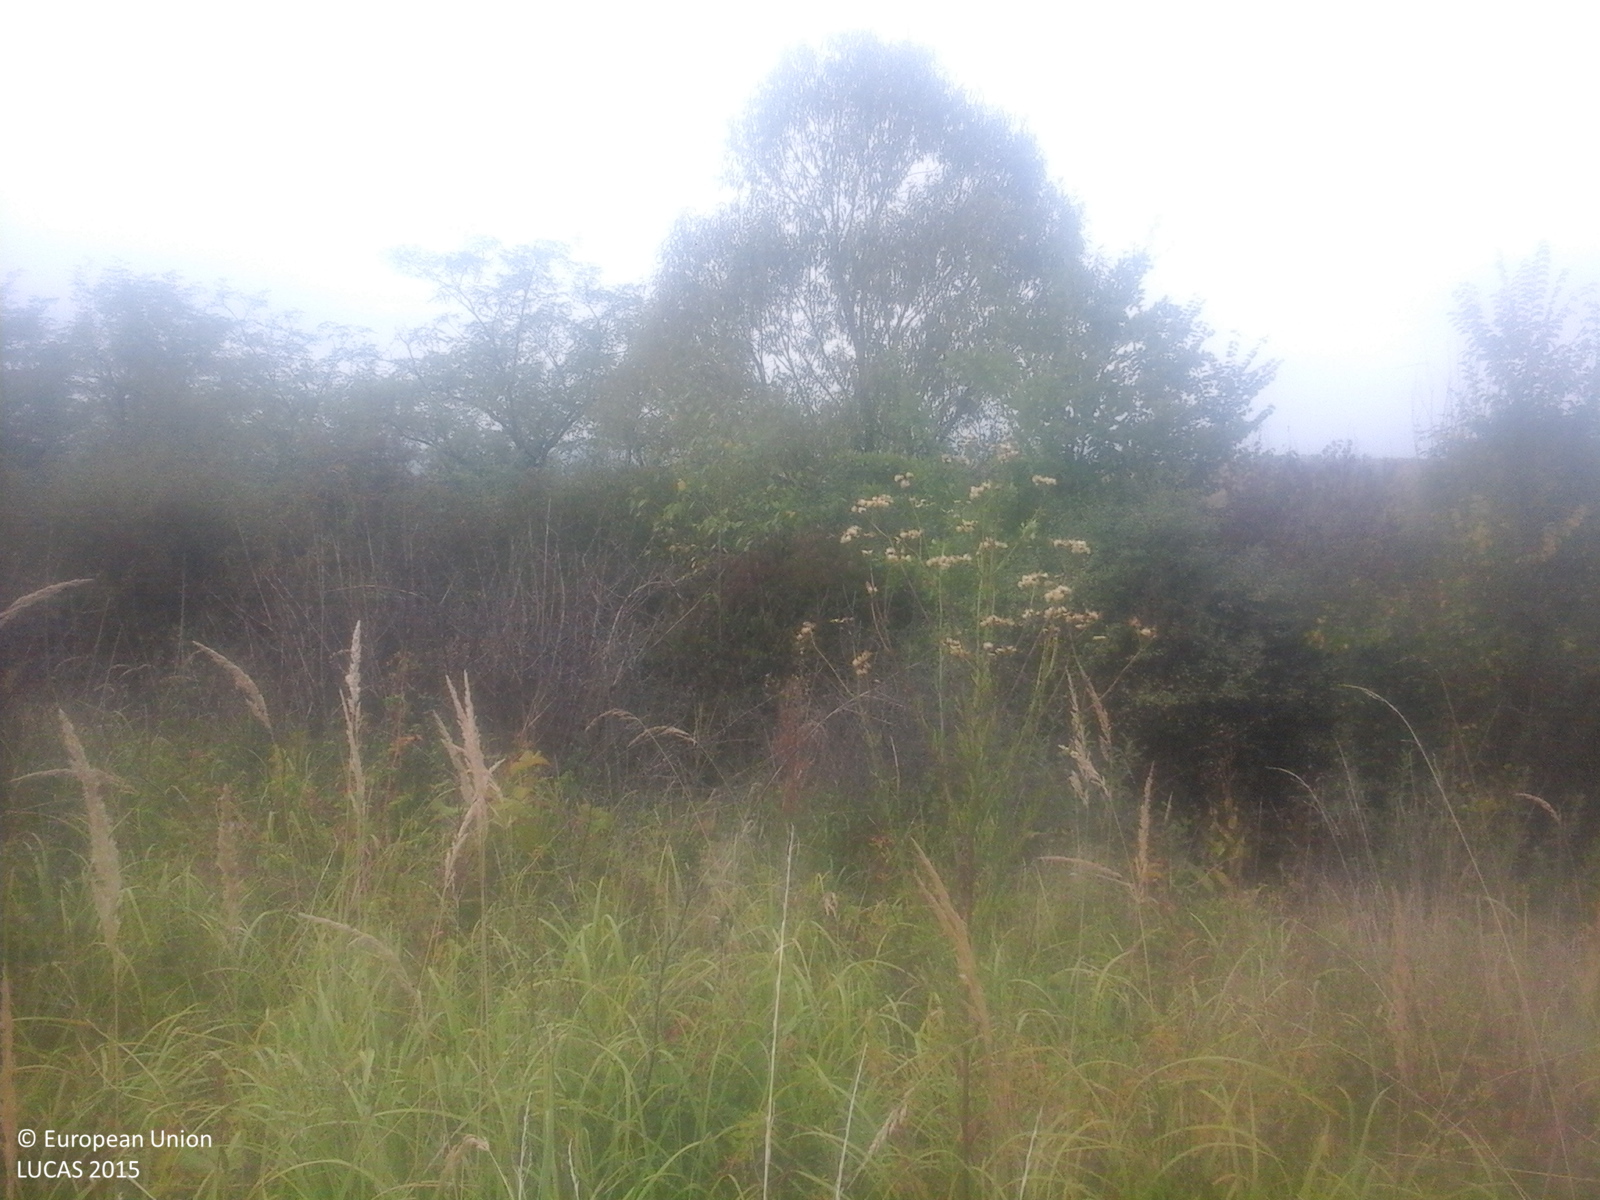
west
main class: Shrubland
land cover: Shrubland without tree cover
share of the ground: > 75 %
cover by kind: shrubs 60 %, herbaceous plants 40 %
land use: Fallow land
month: September
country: RO
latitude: 45.4815
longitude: 21.9225
